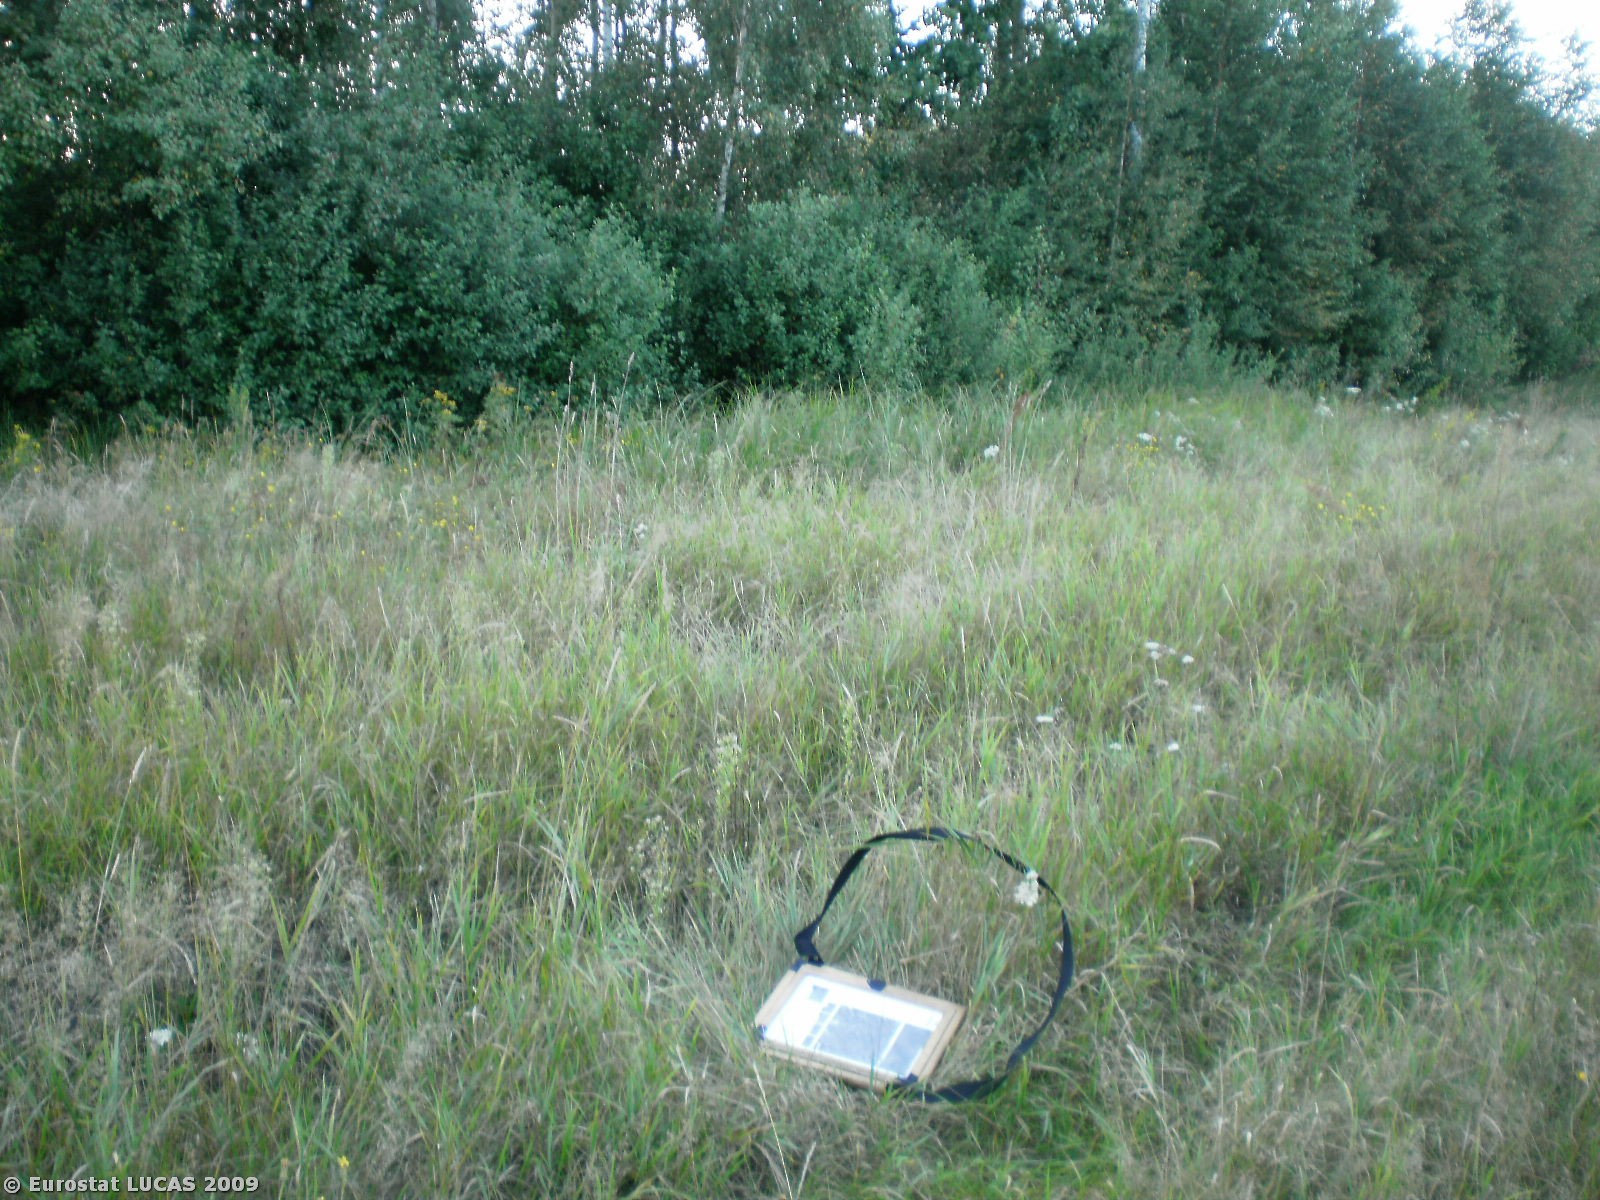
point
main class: Woodland
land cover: Coniferous woodland
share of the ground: > 75 %
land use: Forestry
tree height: < 5 m
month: August
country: PL
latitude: 52.5725
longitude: 21.7554
